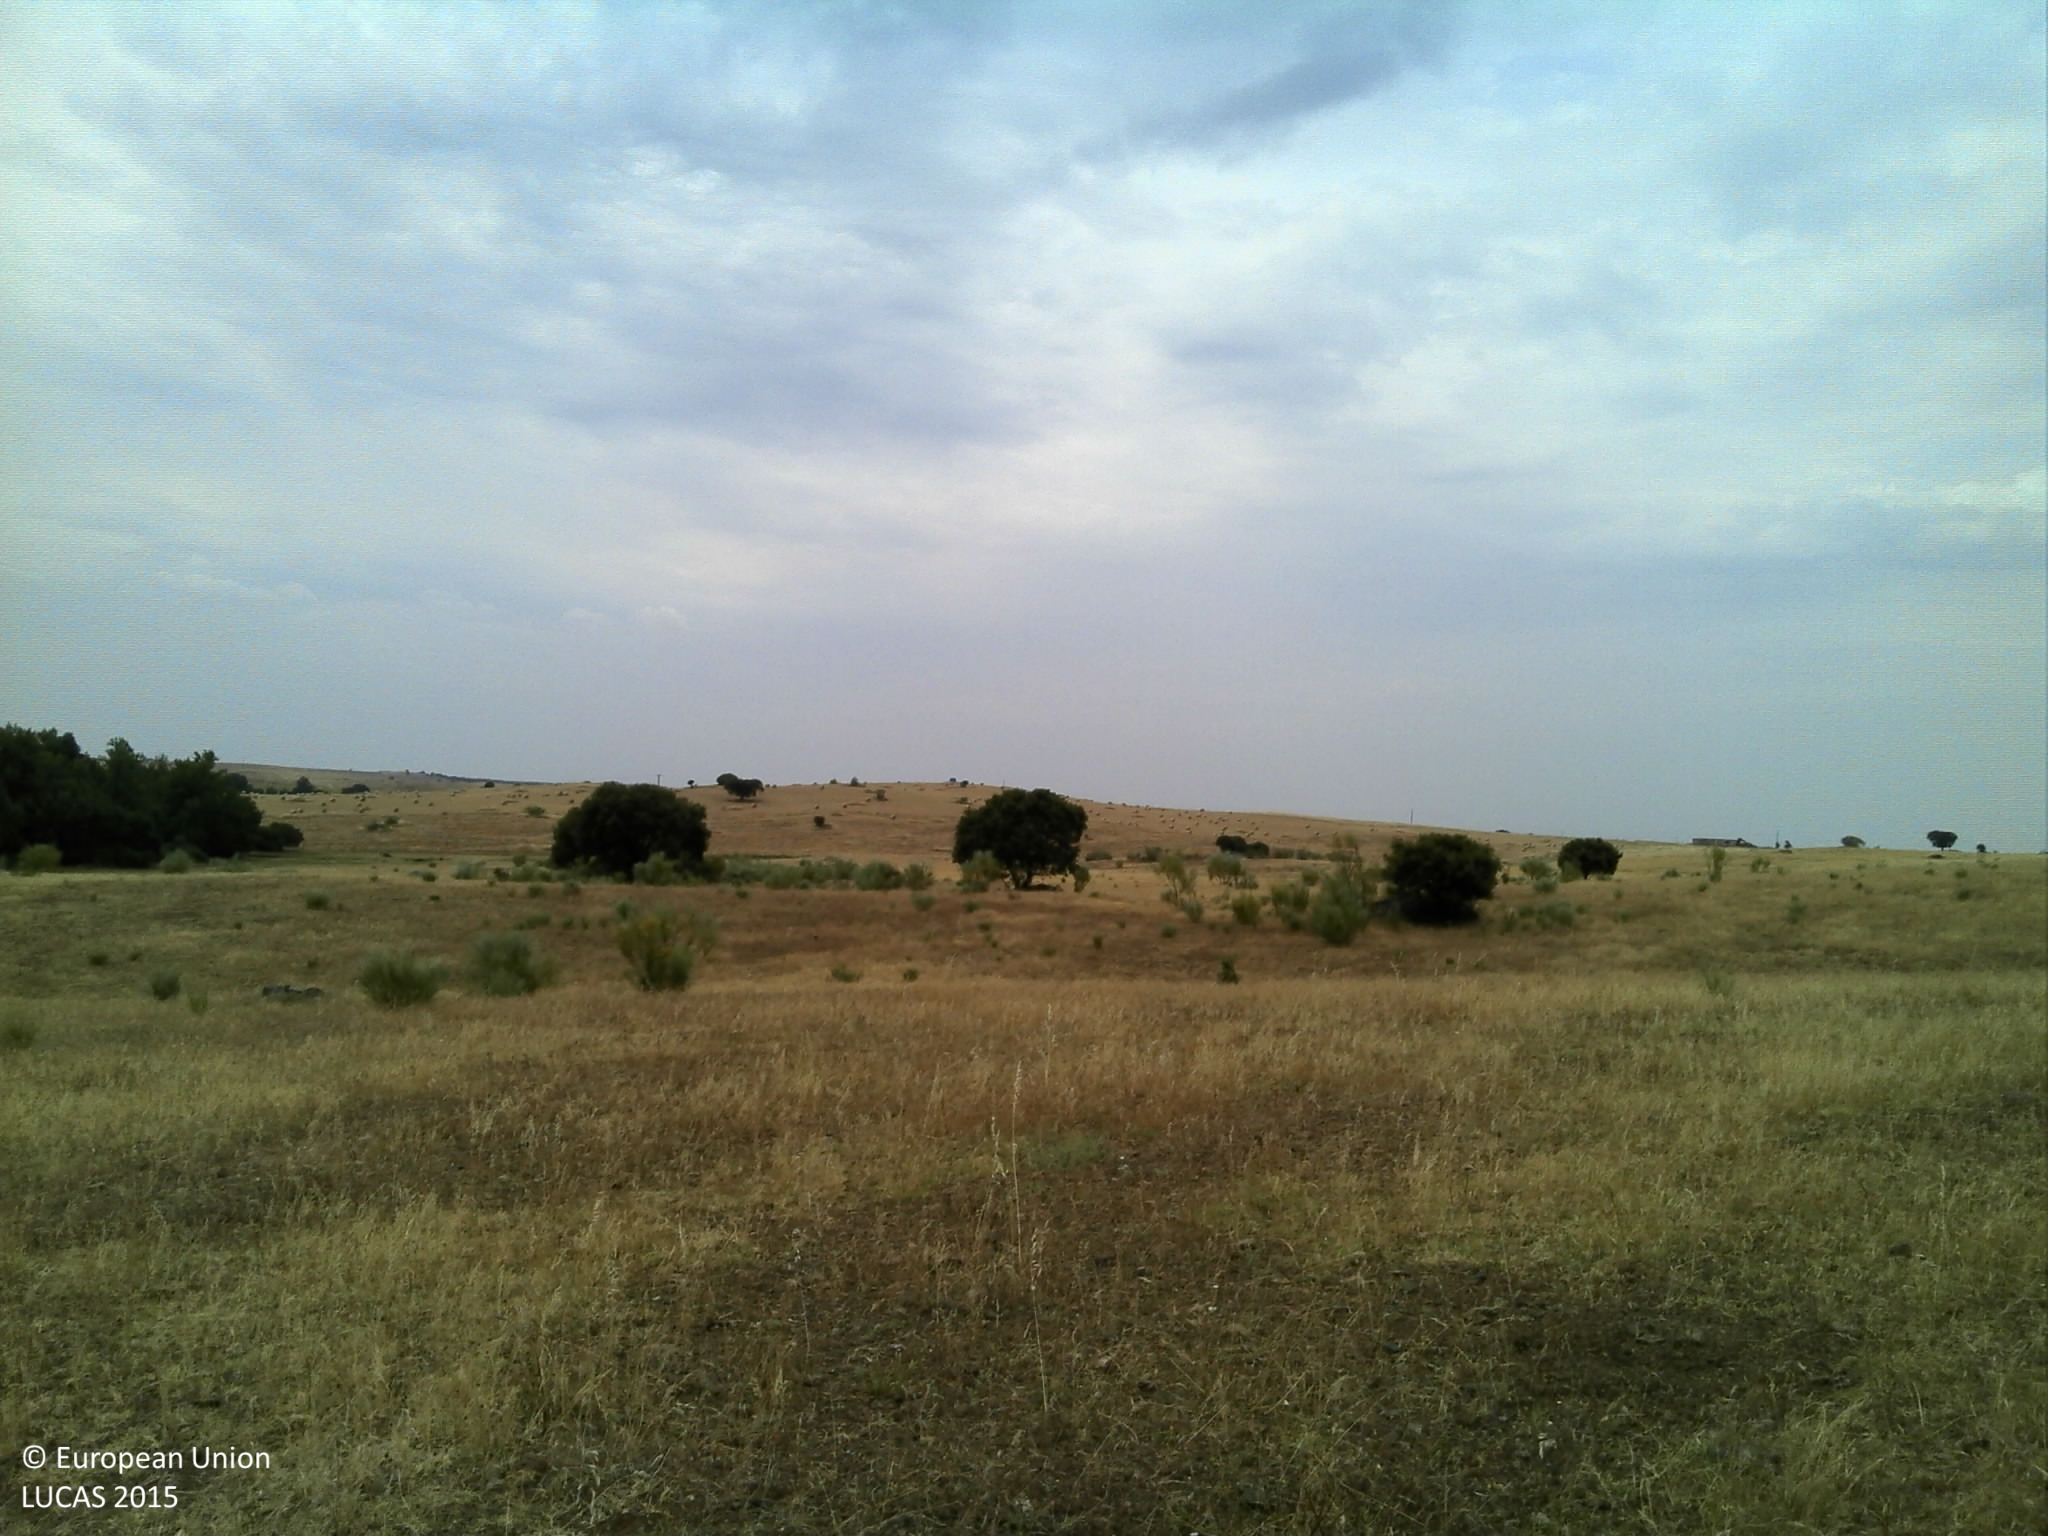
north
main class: Grassland
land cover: Grassland without tree/shrub cover
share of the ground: 25 - 50 %
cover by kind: herbaceous plants 50 %, unconsolidated bare surface 50 %
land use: Agriculture (excluding fallow land and kitchen gardens)
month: June
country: PT
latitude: 38.6101
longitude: -7.7798
